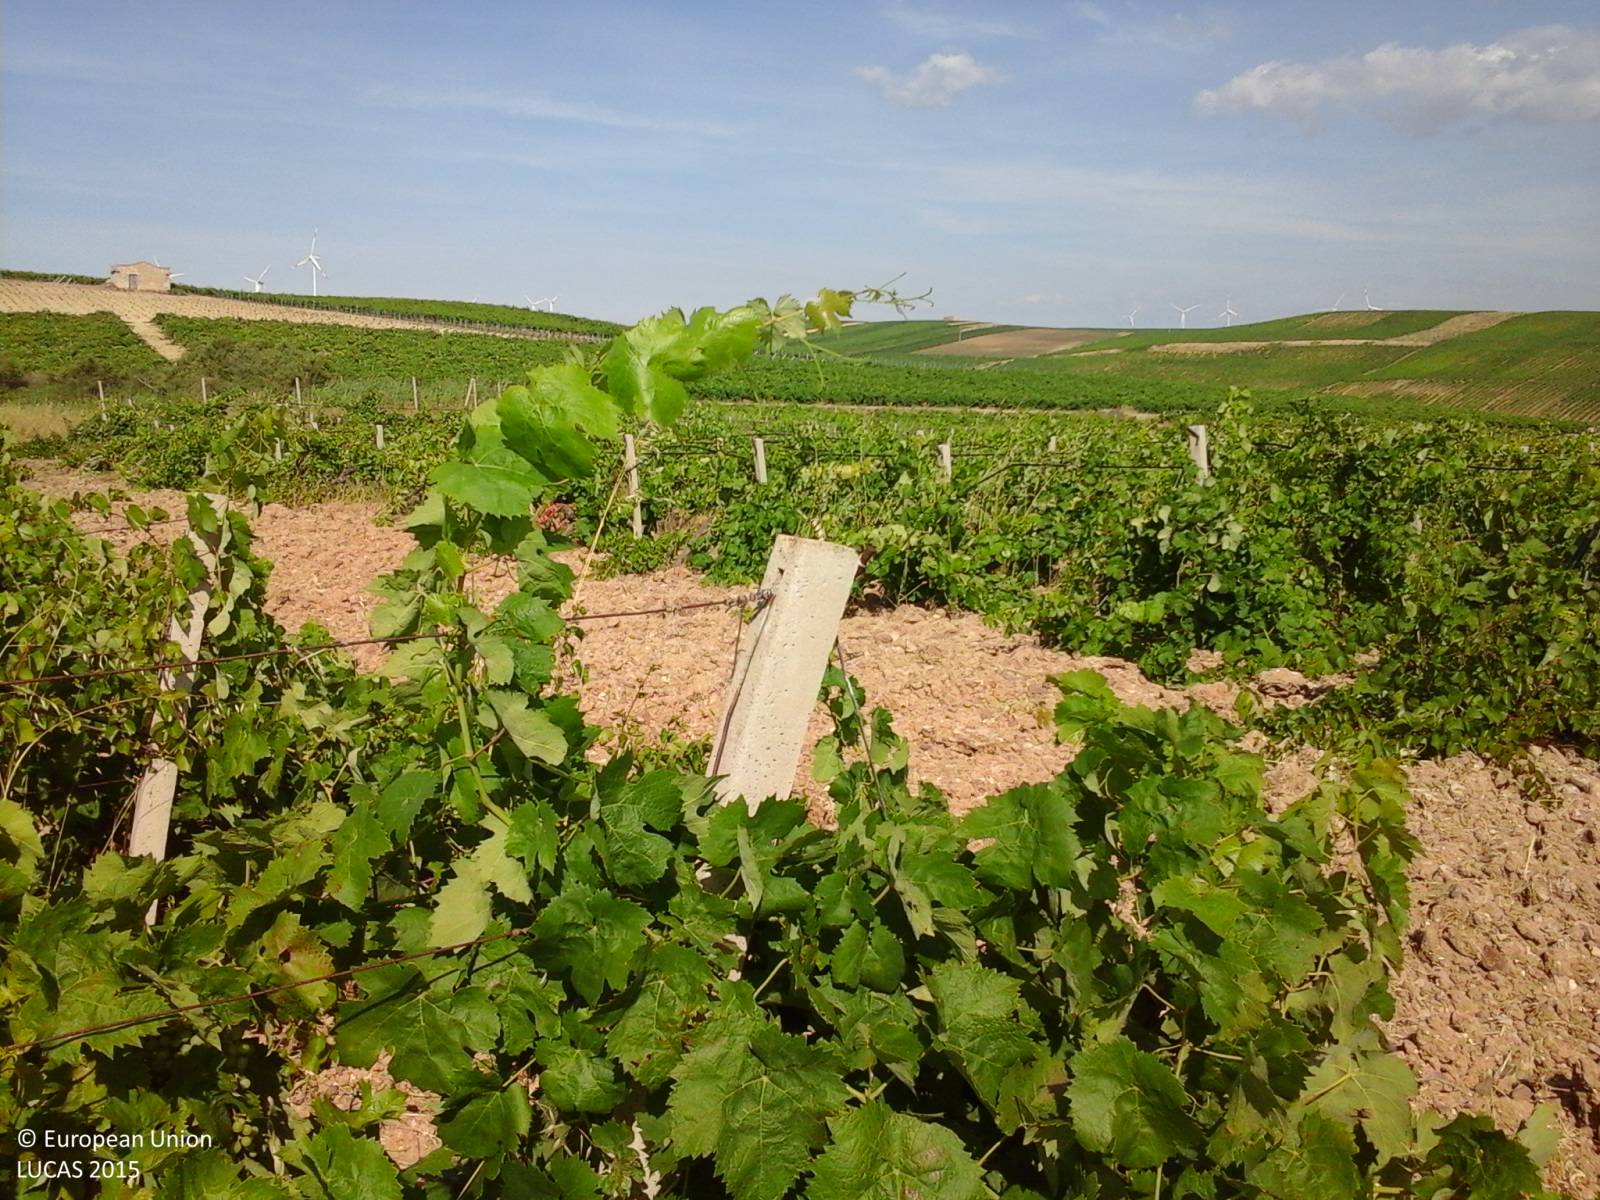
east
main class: Cropland
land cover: Vineyards
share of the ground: 50 - 75 %
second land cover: Other bare soil
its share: > 75 %
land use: Agriculture (excluding fallow land and kitchen gardens)
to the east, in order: Vineyards; Other bare soil
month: June
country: IT
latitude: 37.8190
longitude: 12.6725
